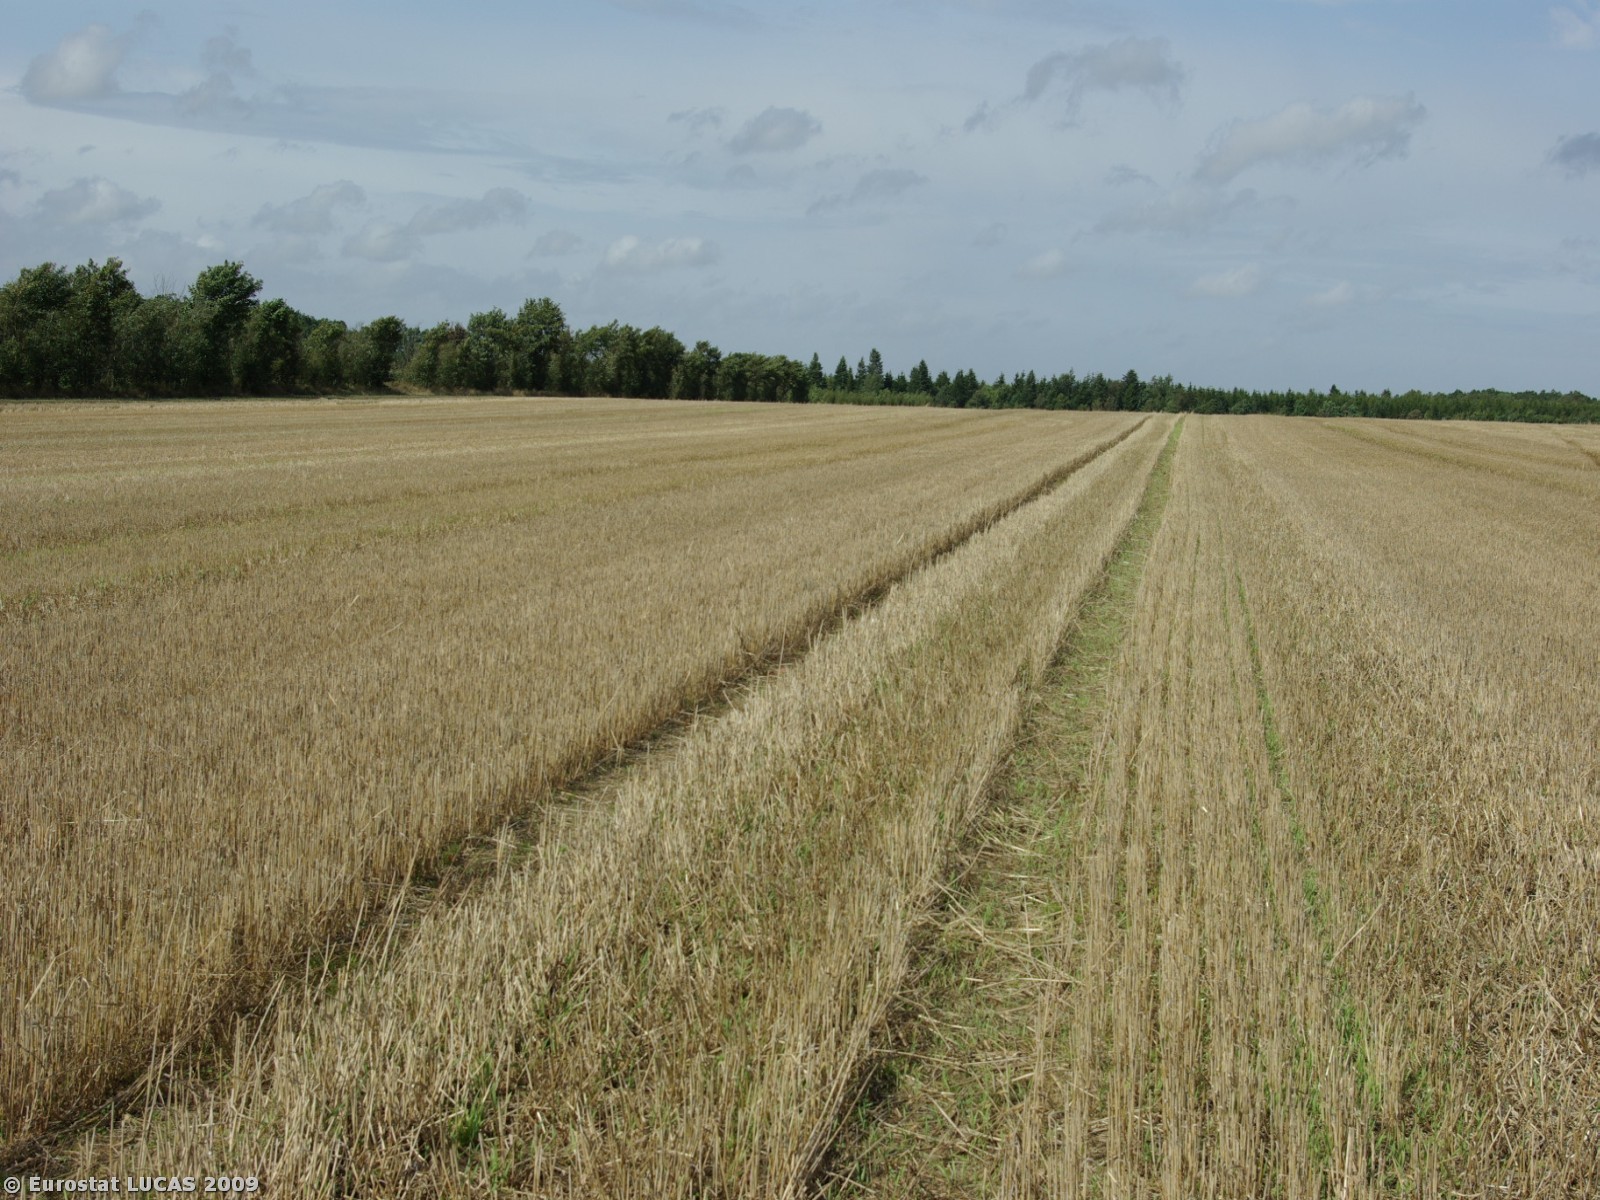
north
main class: Cropland
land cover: Barley
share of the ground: < 10 %
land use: Agriculture (excluding fallow land and kitchen gardens)
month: July
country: DK
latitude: 55.1953
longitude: 9.0111
